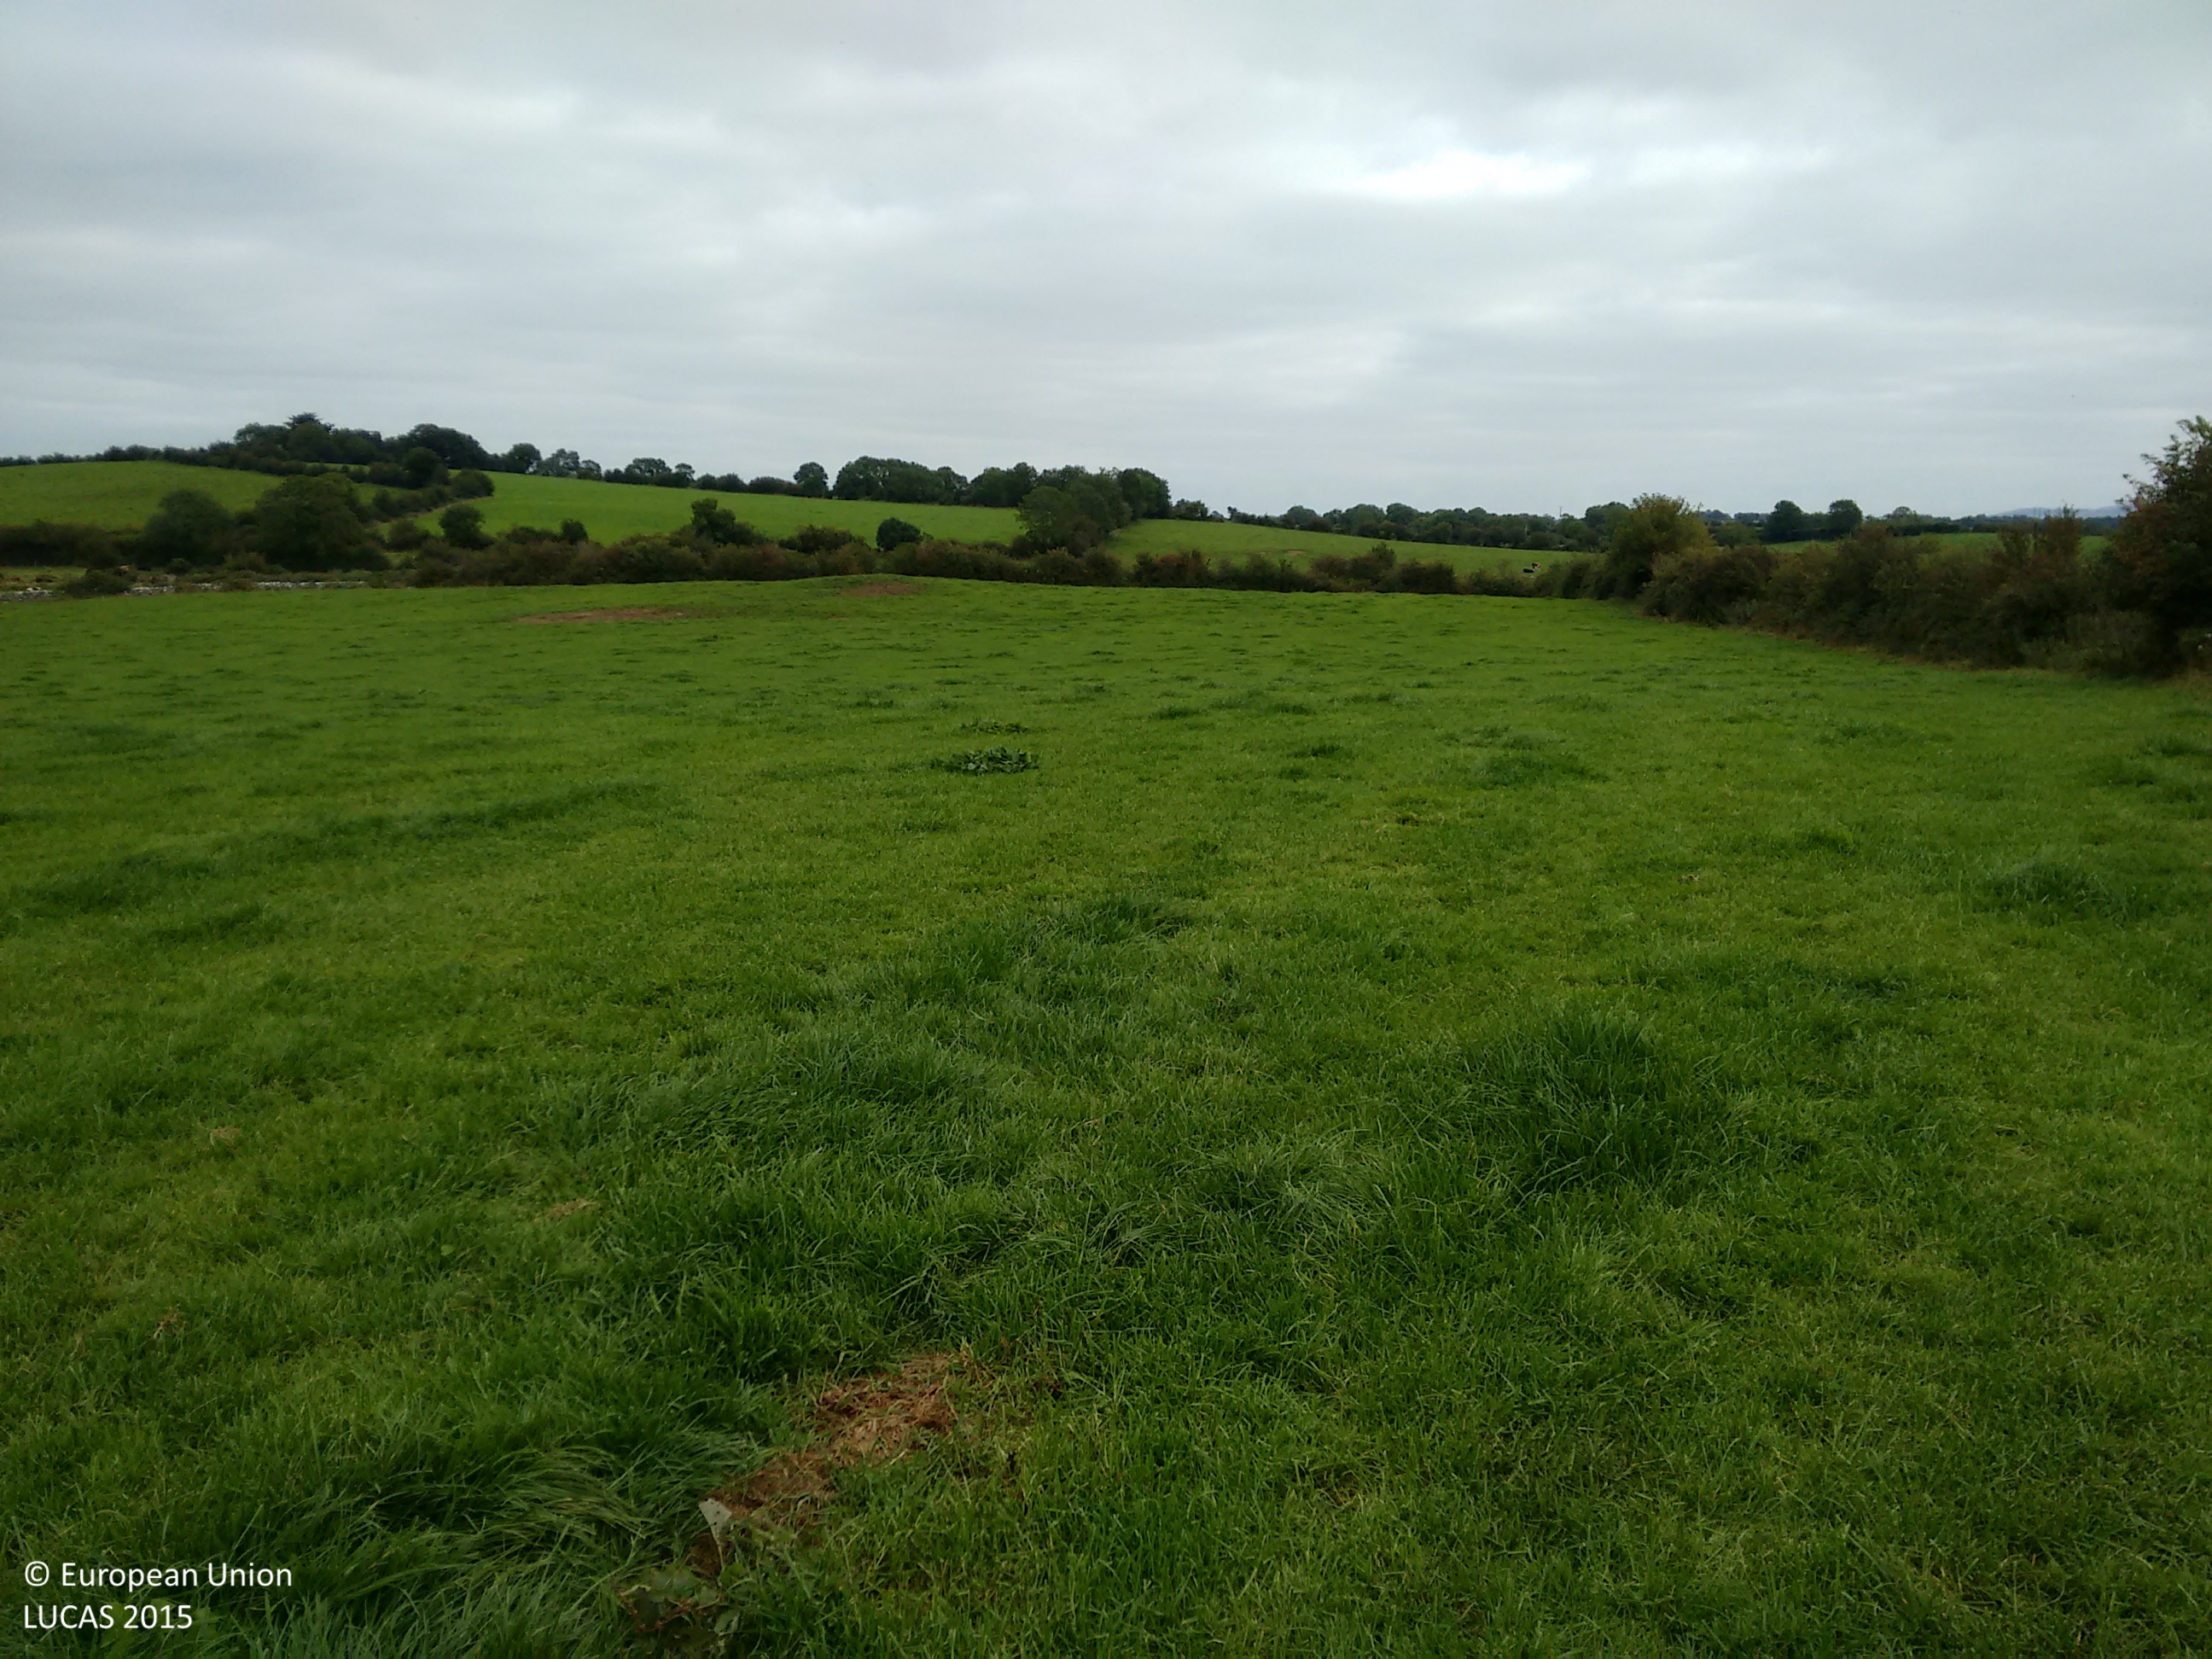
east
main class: Grassland
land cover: Grassland without tree/shrub cover
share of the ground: > 75 %
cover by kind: herbaceous plants 100 %
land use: Agriculture (excluding fallow land and kitchen gardens)
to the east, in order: Grassland without tree/shrub cover; Fences; Abandoned hedges; Fences; Grassland without tree/shrub cover; Fences; Grassland without tree/shrub cover
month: September
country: IE
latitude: 52.5232
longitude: -9.0049
